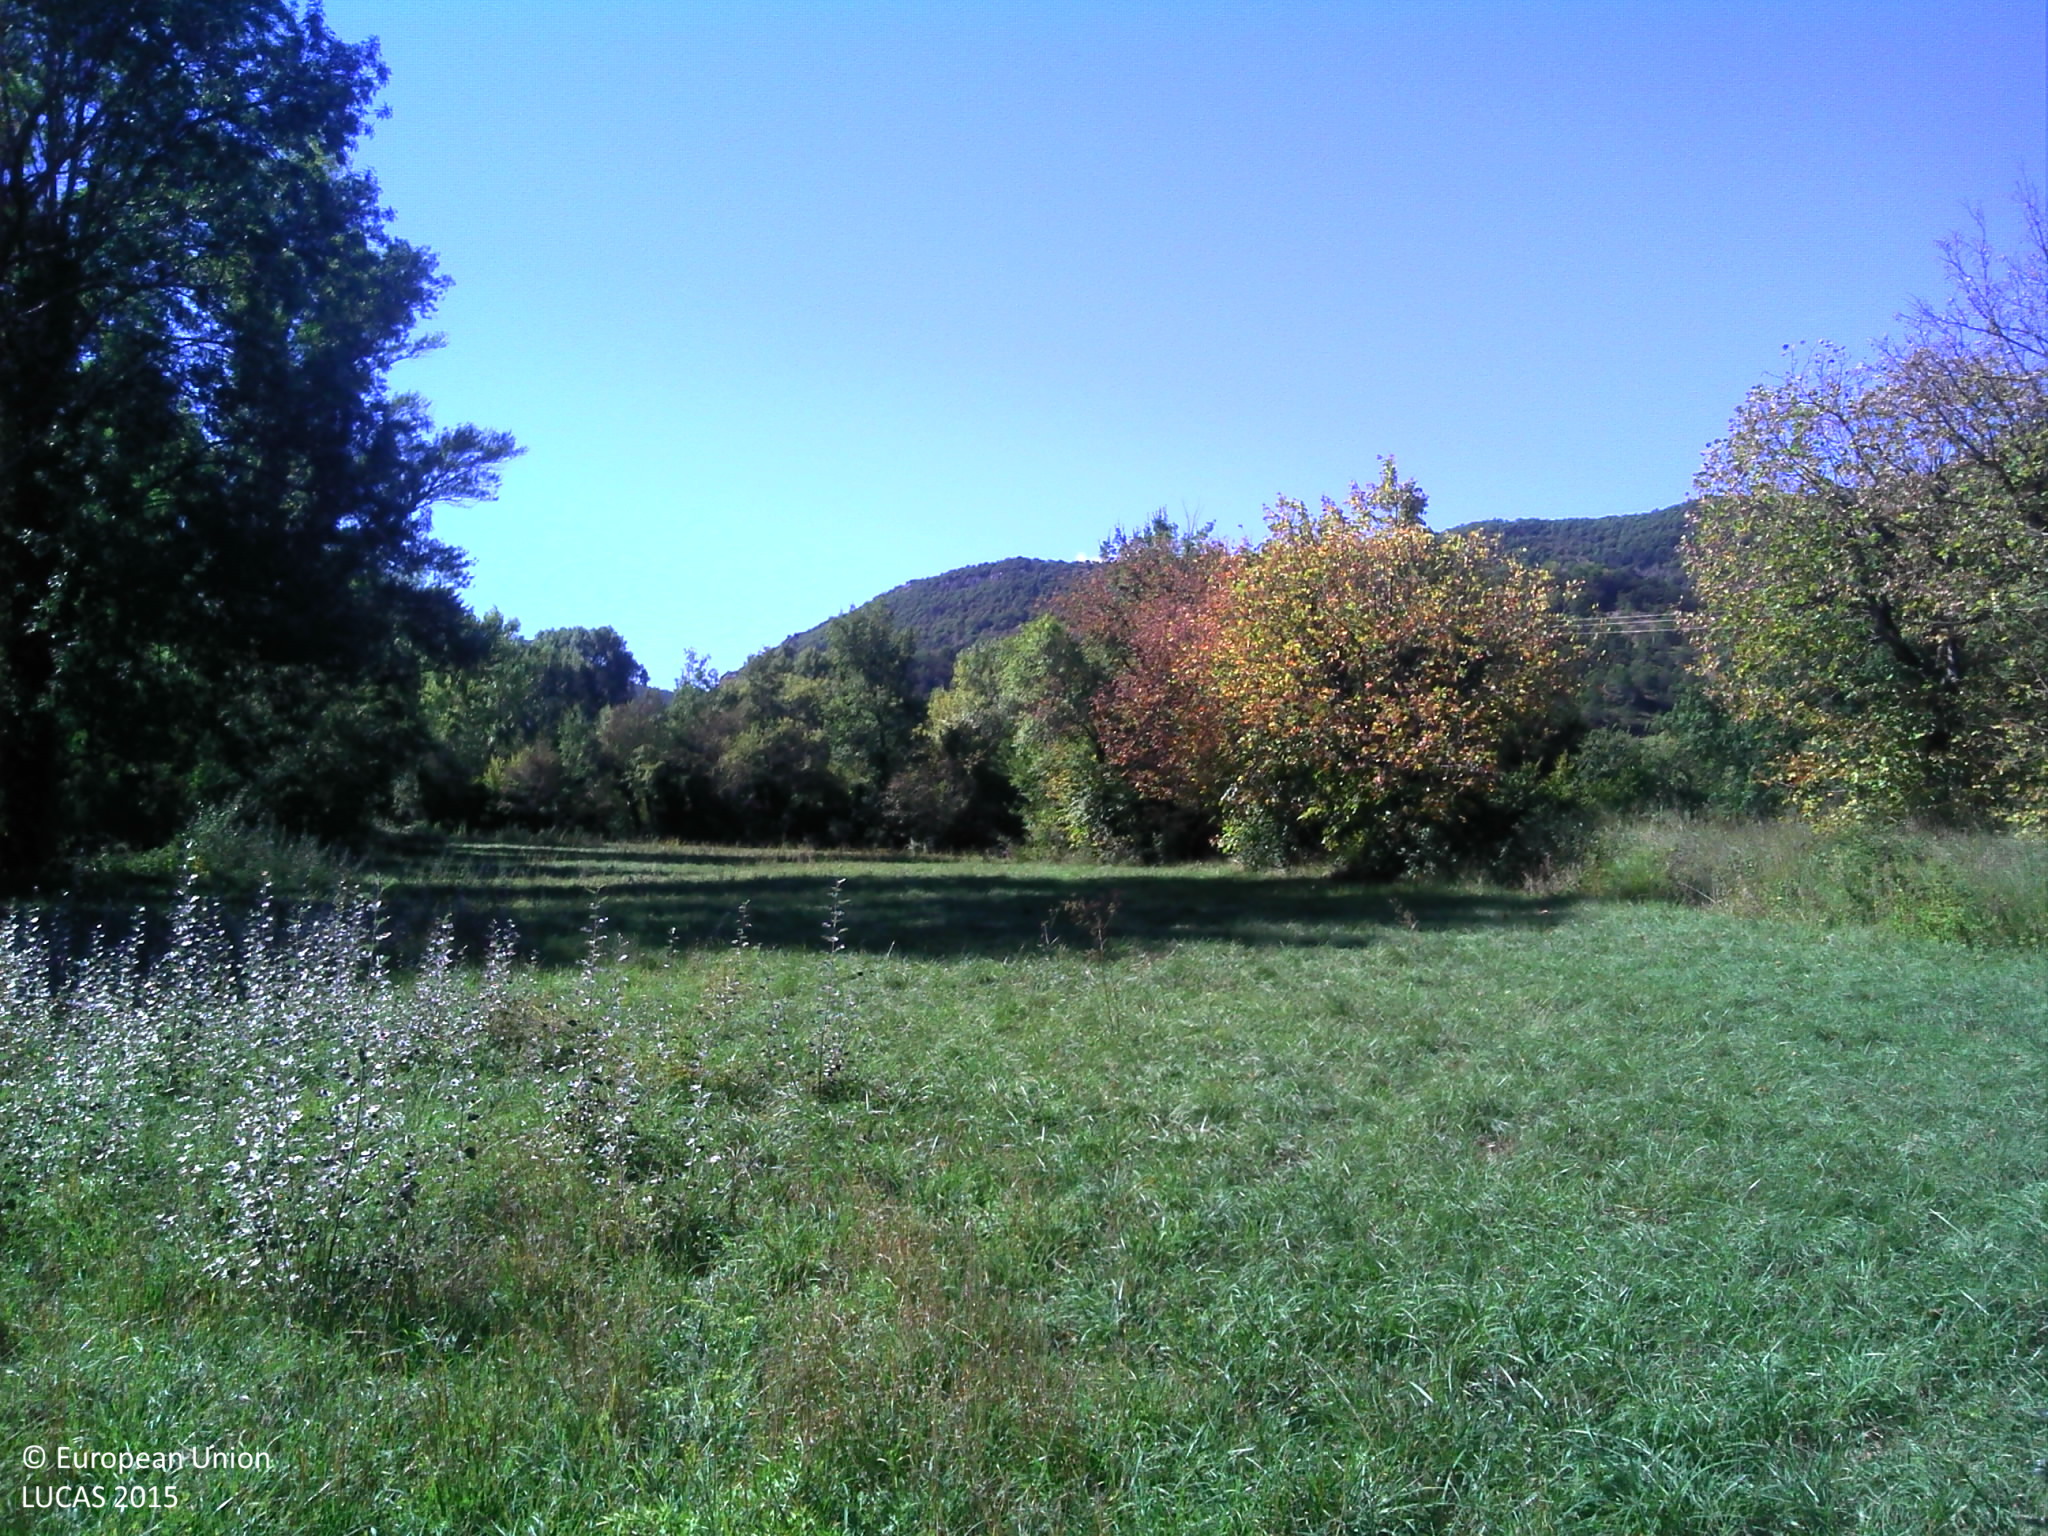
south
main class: Grassland
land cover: Grassland without tree/shrub cover
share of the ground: > 75 %
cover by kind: herbaceous plants 100 %
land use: Agriculture (excluding fallow land and kitchen gardens)
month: November
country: FR
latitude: 44.4020
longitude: 5.1983
